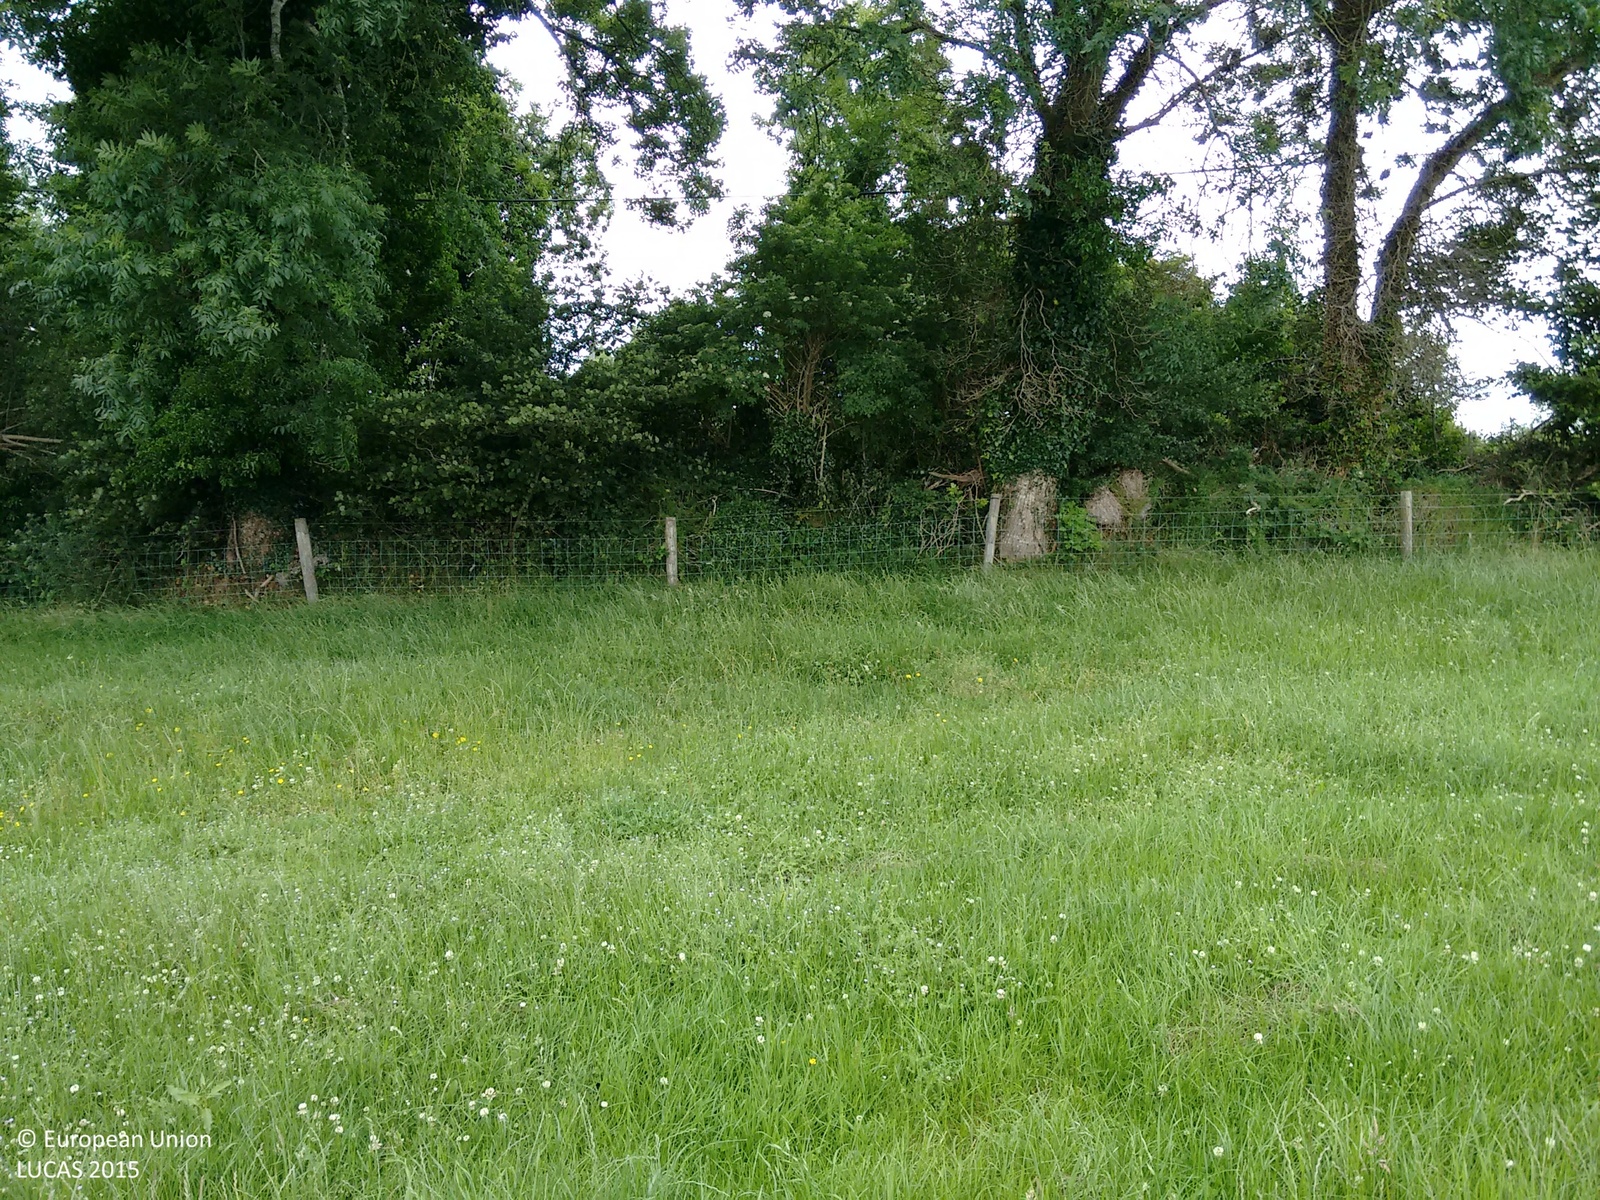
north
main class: Grassland
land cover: Grassland without tree/shrub cover
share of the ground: > 75 %
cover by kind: herbaceous plants 100 %
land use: Agriculture (excluding fallow land and kitchen gardens)
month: July
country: IE
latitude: 53.3978
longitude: -8.0279
